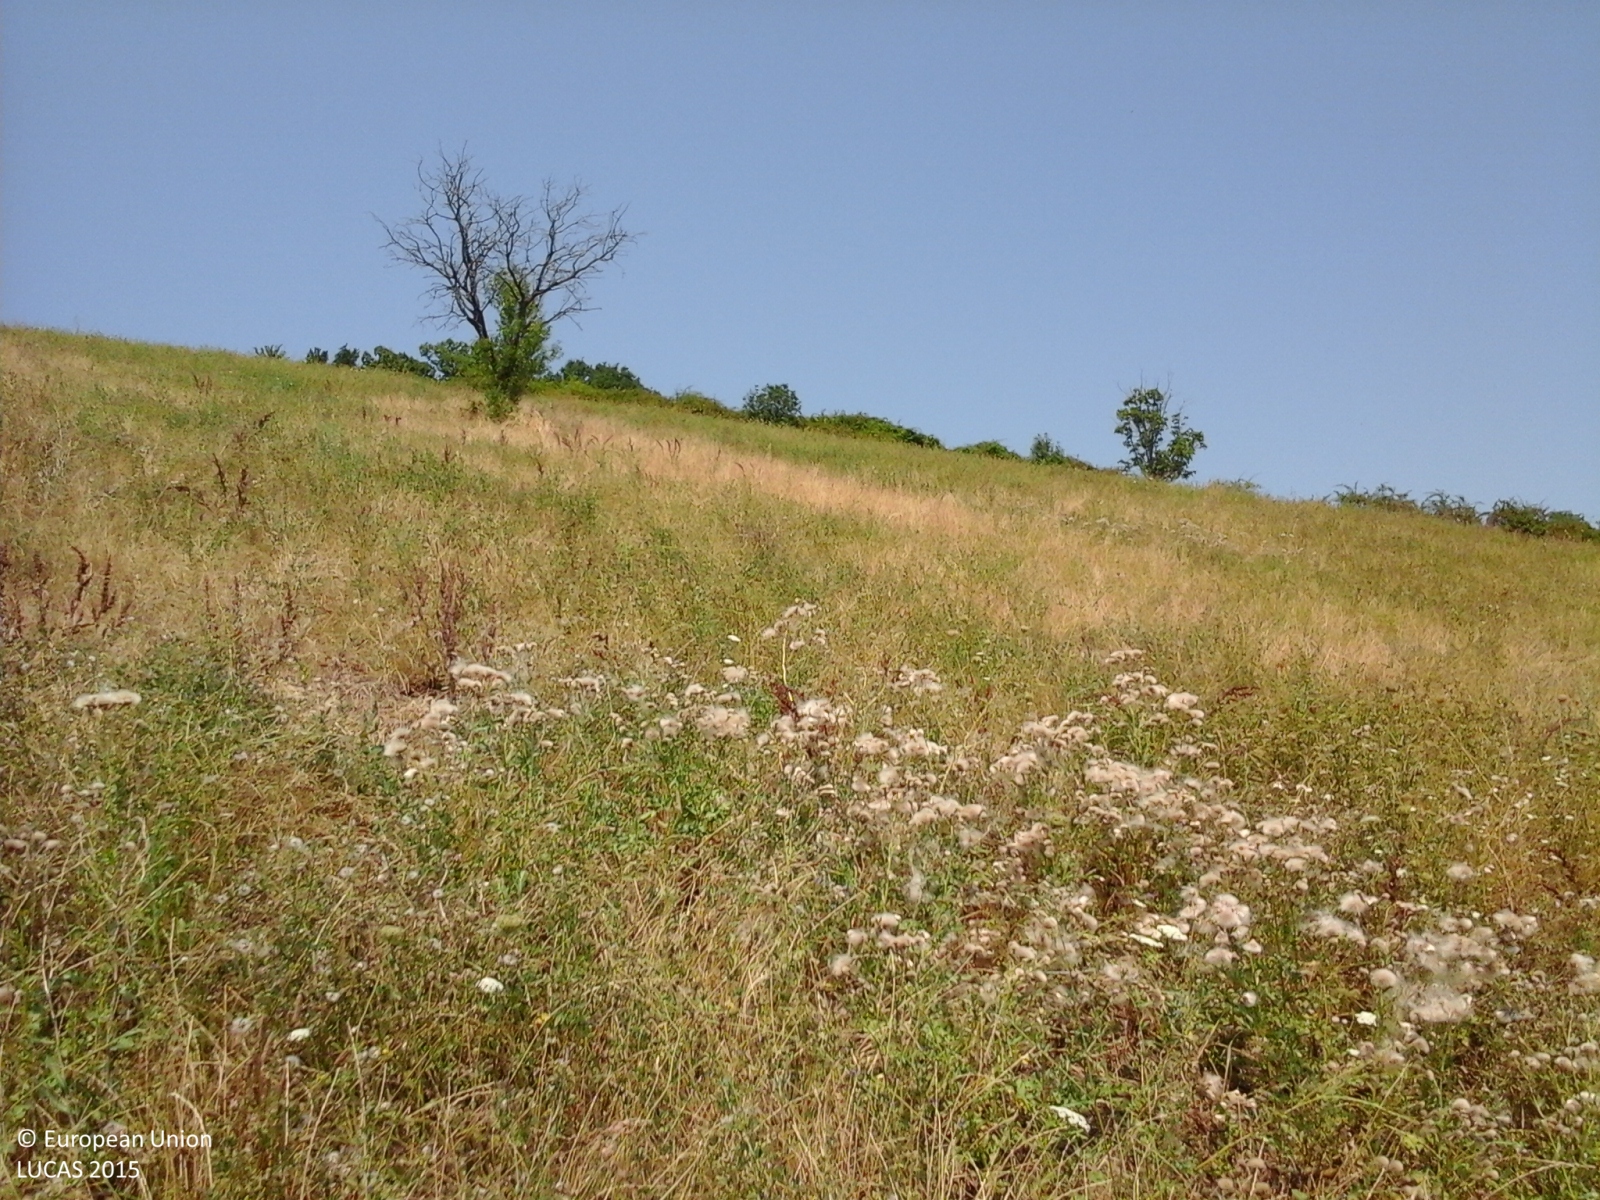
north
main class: Grassland
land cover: Spontaneously vegetated surfaces
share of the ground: > 75 %
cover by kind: herbaceous plants 100 %
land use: Fallow land
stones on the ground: < 10 %
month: August
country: IT
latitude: 43.7461
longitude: 12.3659
